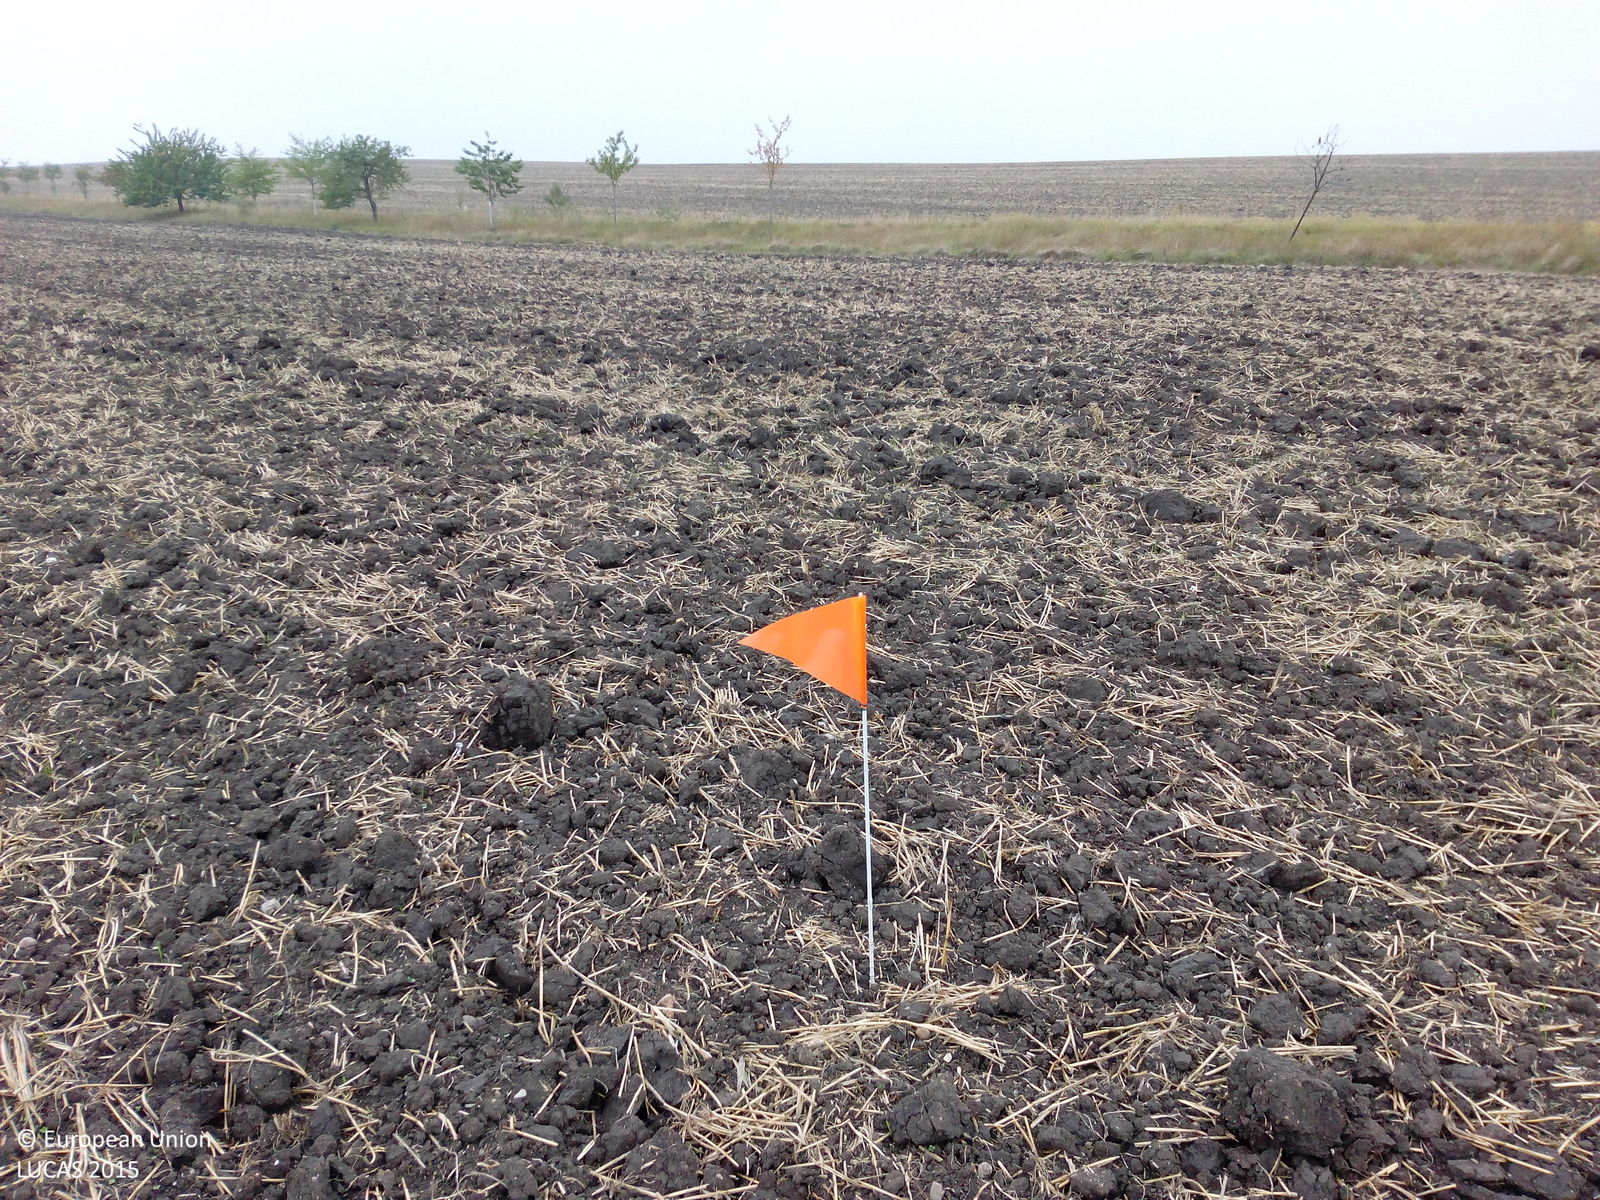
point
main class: Cropland
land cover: Common wheat
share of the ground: < 10 %
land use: Agriculture (excluding fallow land and kitchen gardens)
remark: Harvested field
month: August
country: DE
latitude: 51.0421
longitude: 11.0979
